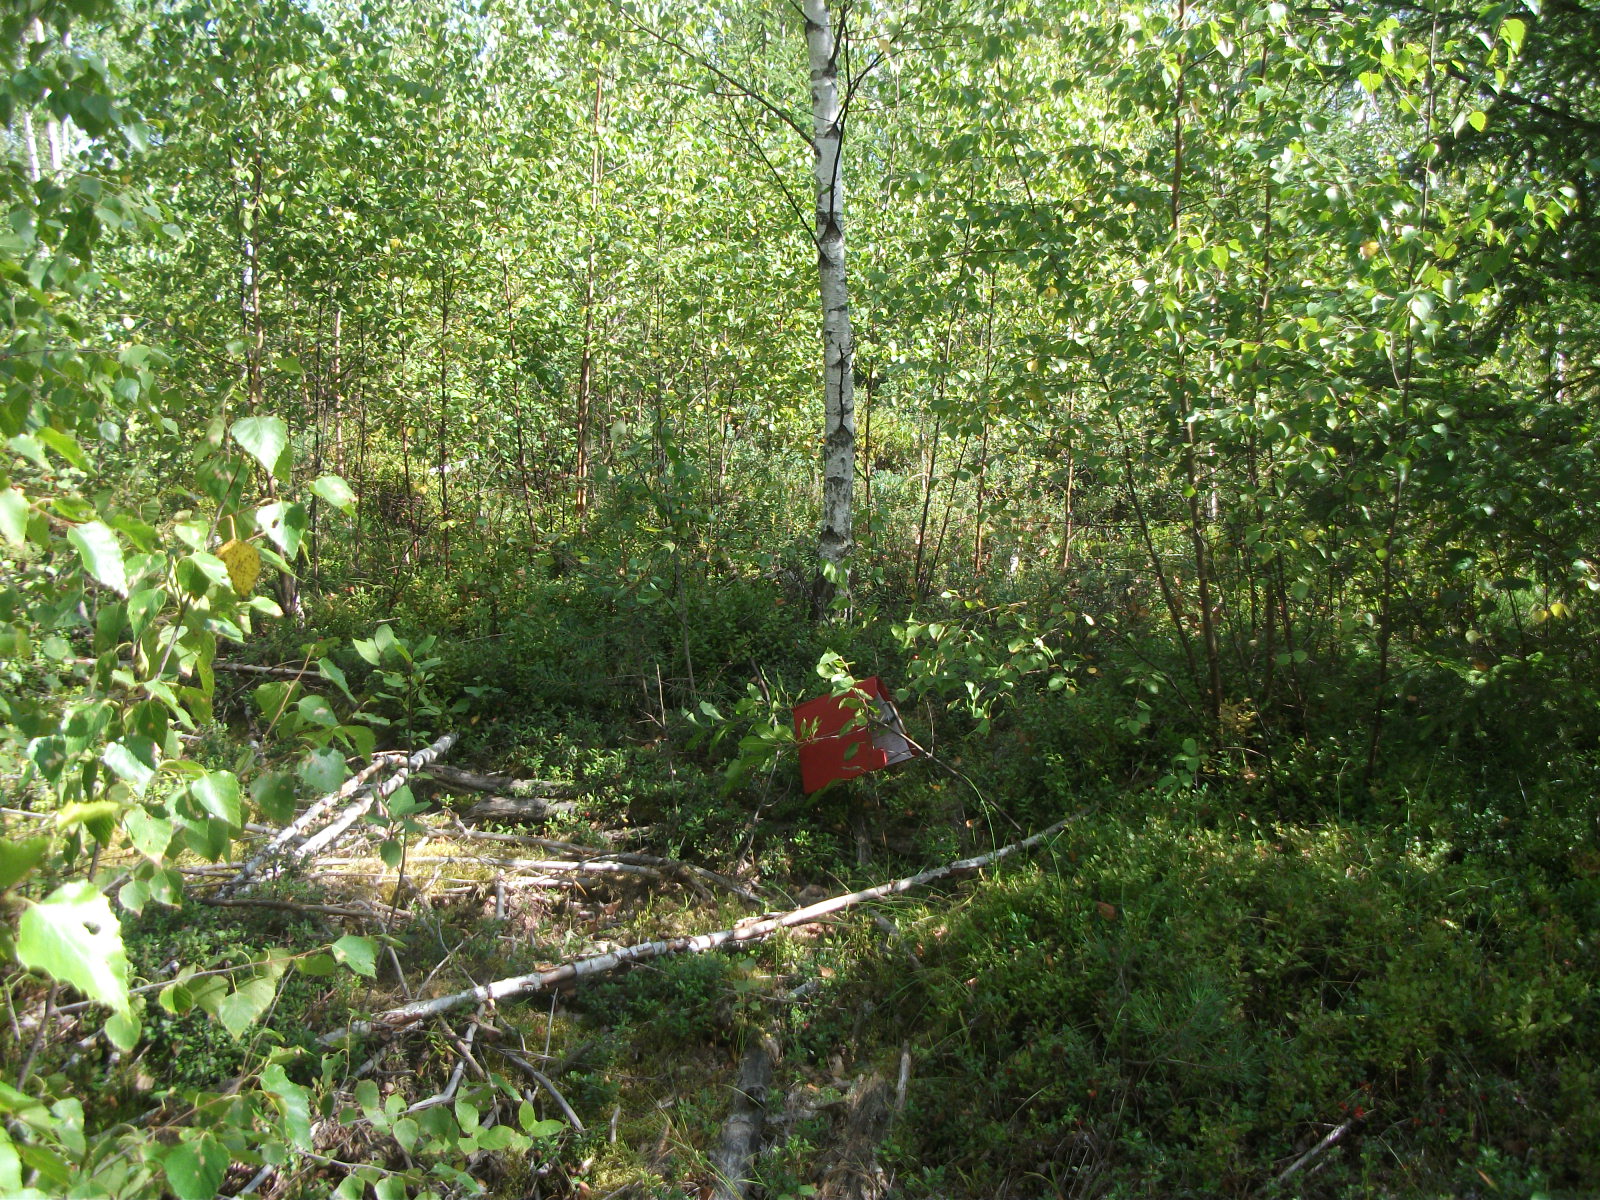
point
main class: Woodland
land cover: Broadleaved woodland
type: non-riverine alder, birch or aspen forest
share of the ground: > 75 %
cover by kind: broadleaved forest trees 80 %, lichens and mosses 15 %, coniferous forest trees 5 %
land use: Forestry
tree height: > 5 m
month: August
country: LV
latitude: 56.5907
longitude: 26.2787
